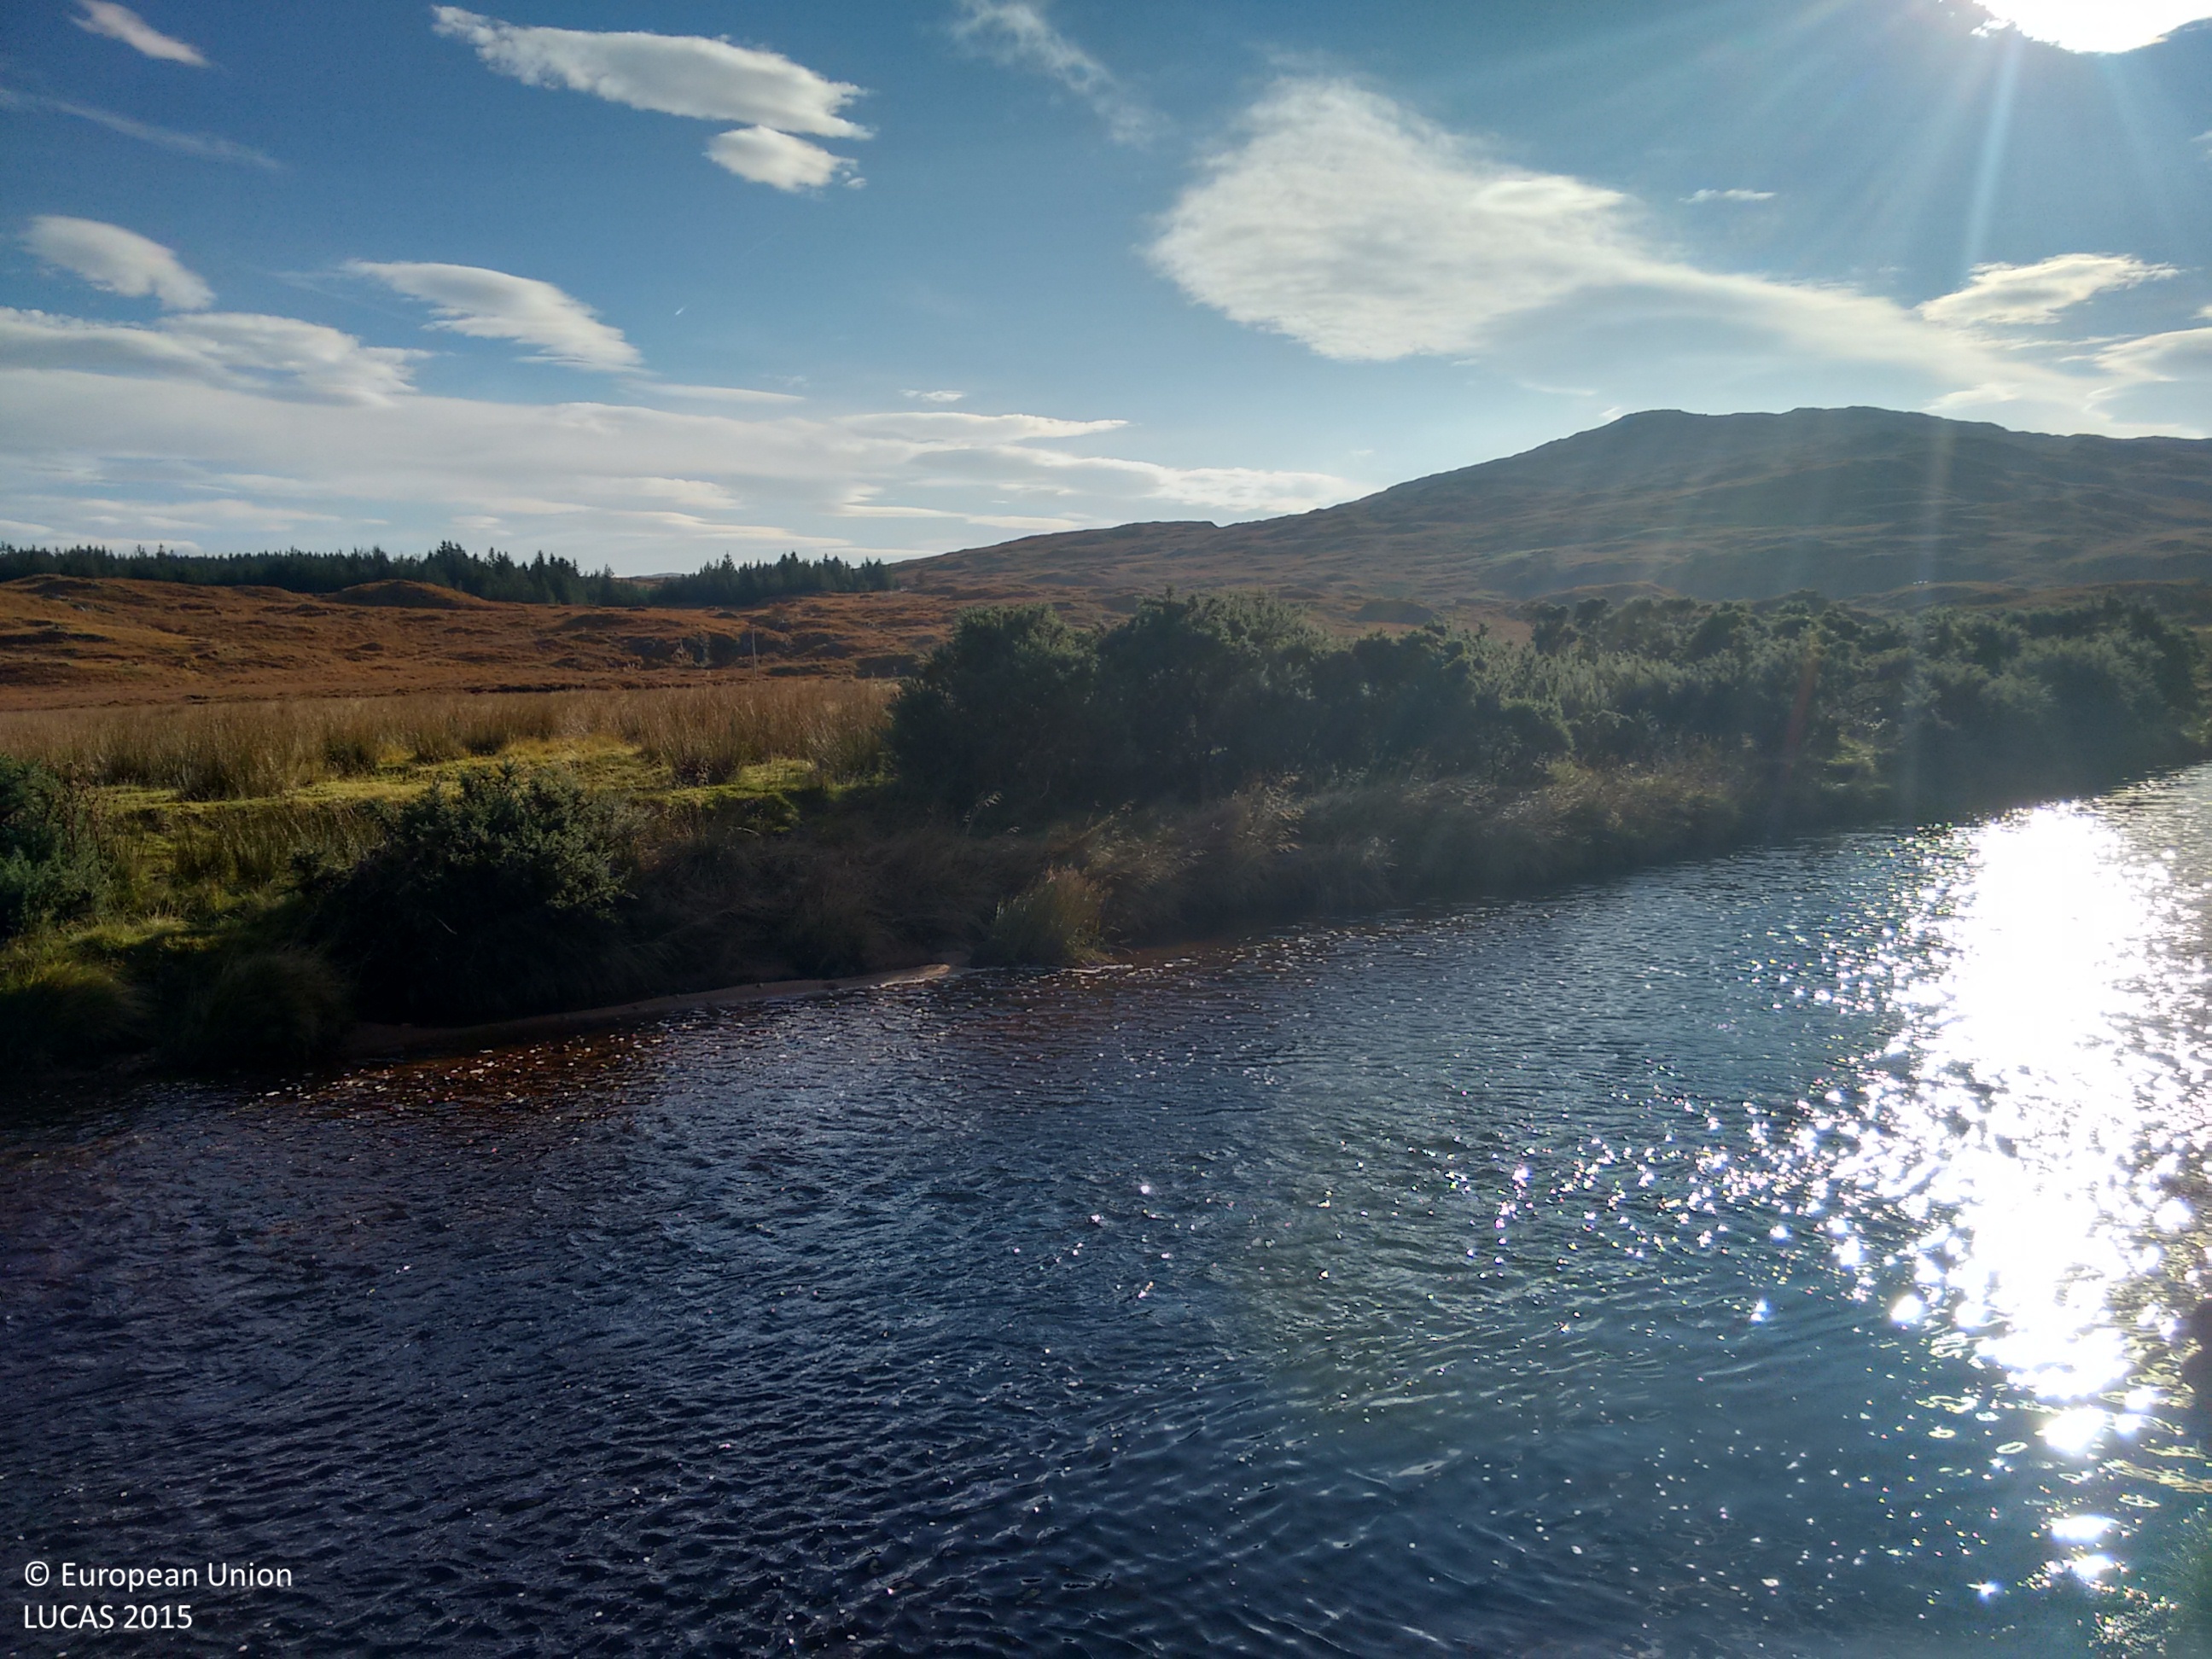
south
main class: Grassland
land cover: Grassland without tree/shrub cover
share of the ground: > 75 %
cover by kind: herbaceous plants 100 %
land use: Agriculture (excluding fallow land and kitchen gardens)
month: October
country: GB
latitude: 56.5925
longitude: -5.6765
